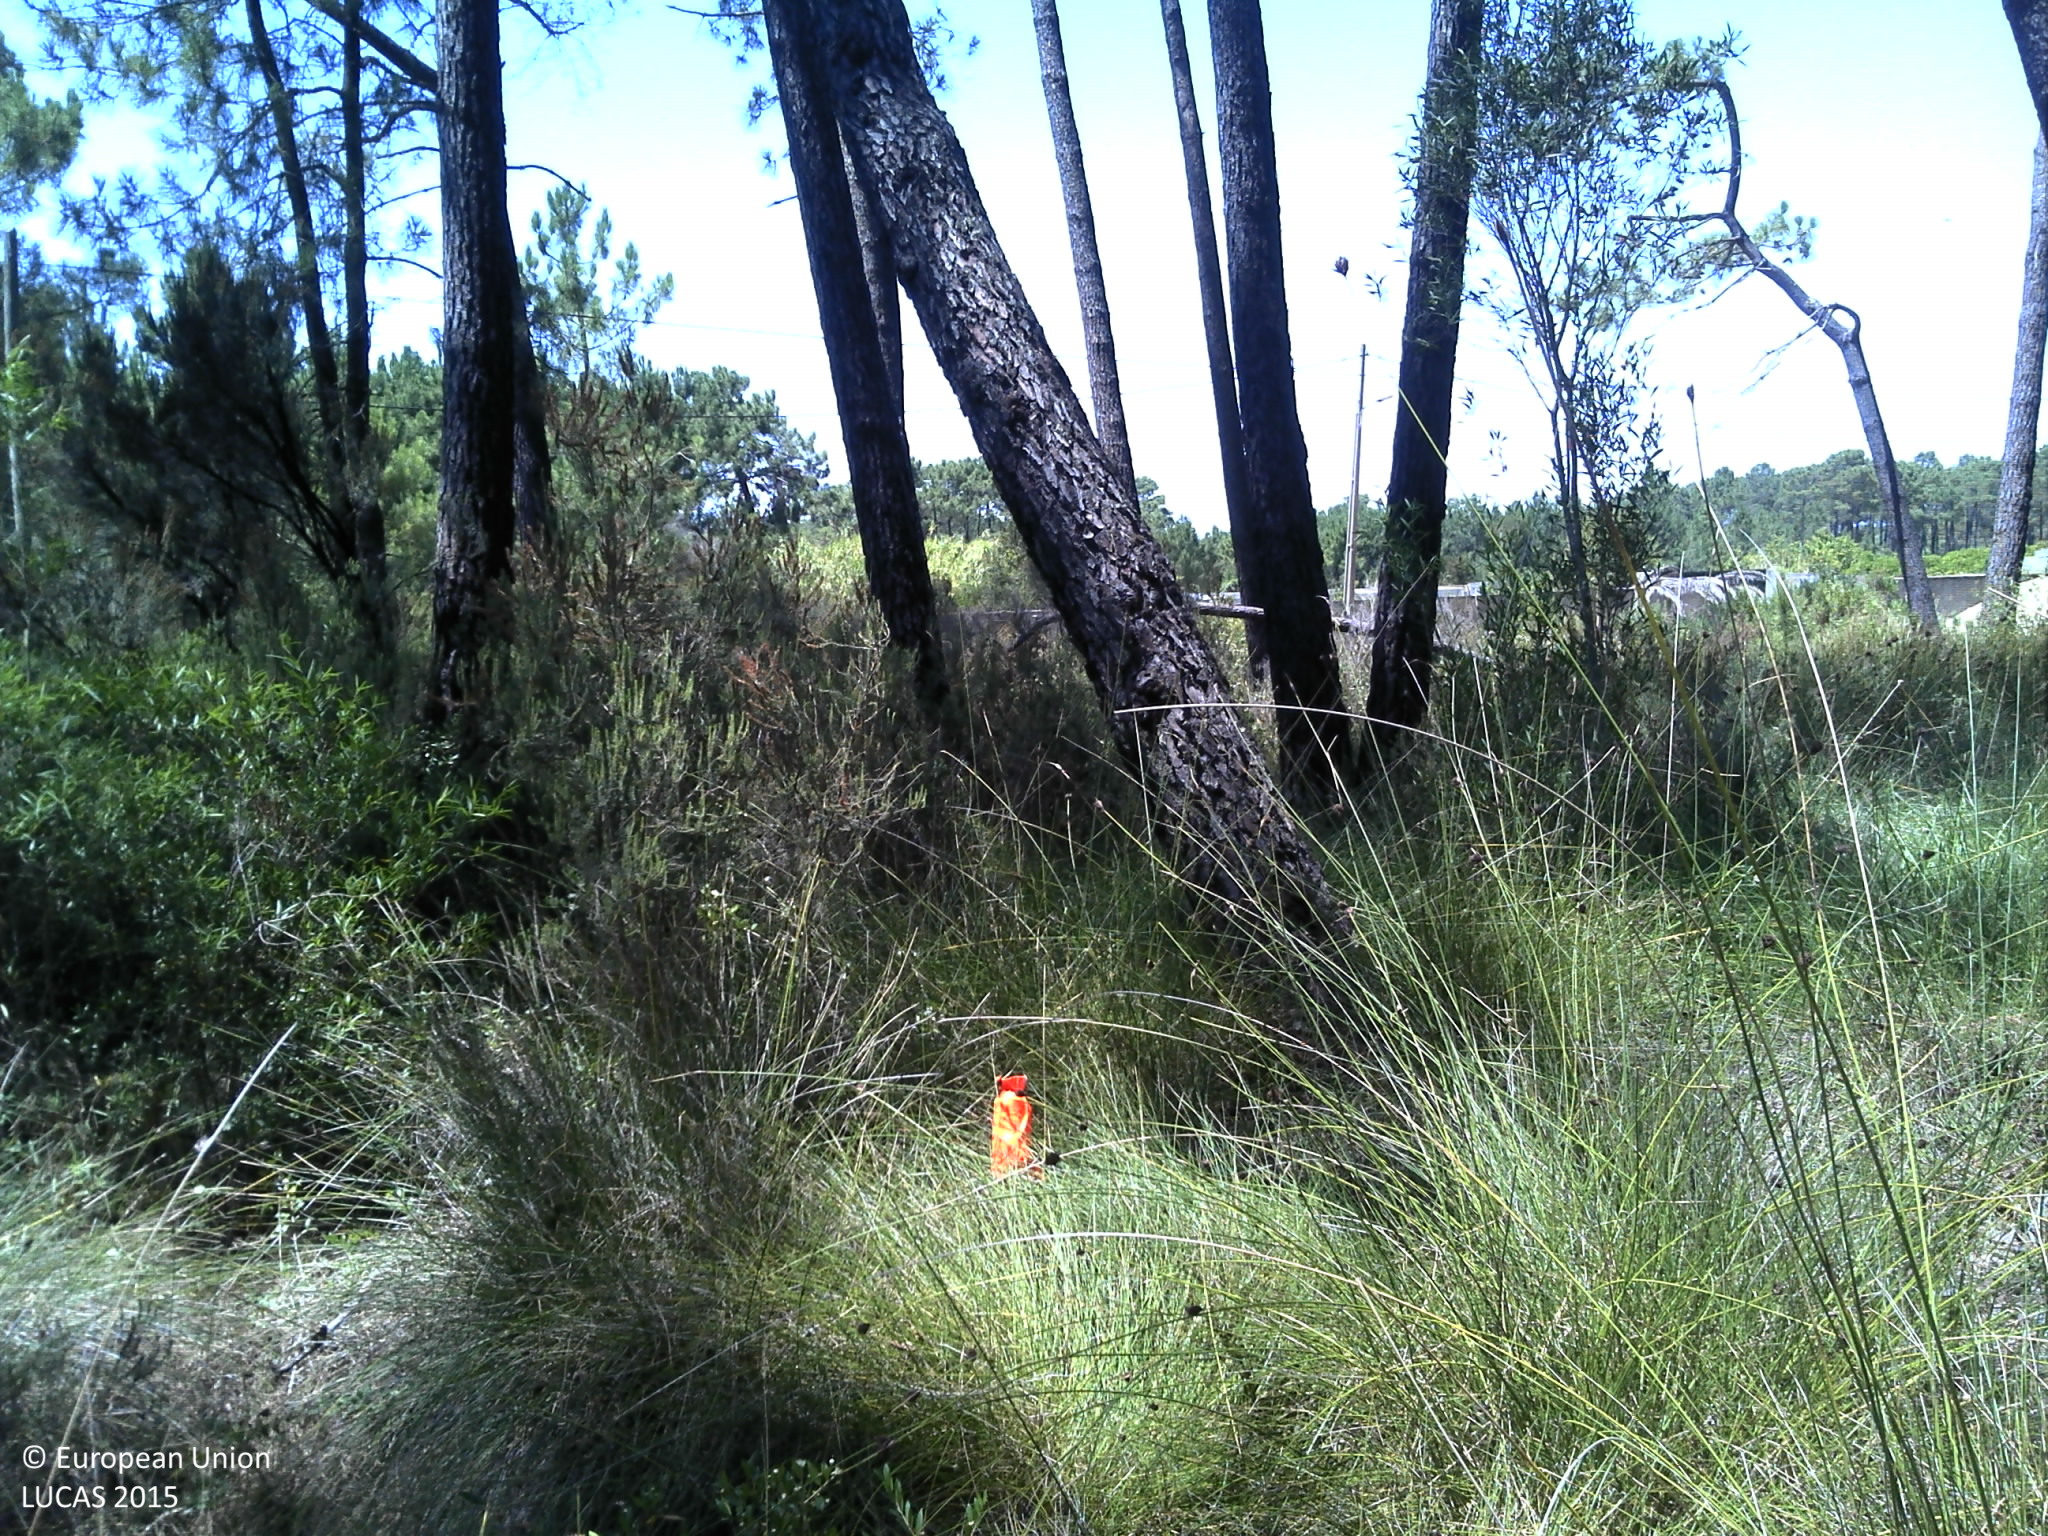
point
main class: Woodland
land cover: Pine dominated coniferous woodland
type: coniferous forest of the mediterranean region
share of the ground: > 75 %
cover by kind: coniferous forest trees 75 %, herbaceous plants 10 %, lichens and mosses 10 %, unconsolidated bare surface 5 %
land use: Forestry
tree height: > 5 m
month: June
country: PT
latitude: 38.5722
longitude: -9.1131
